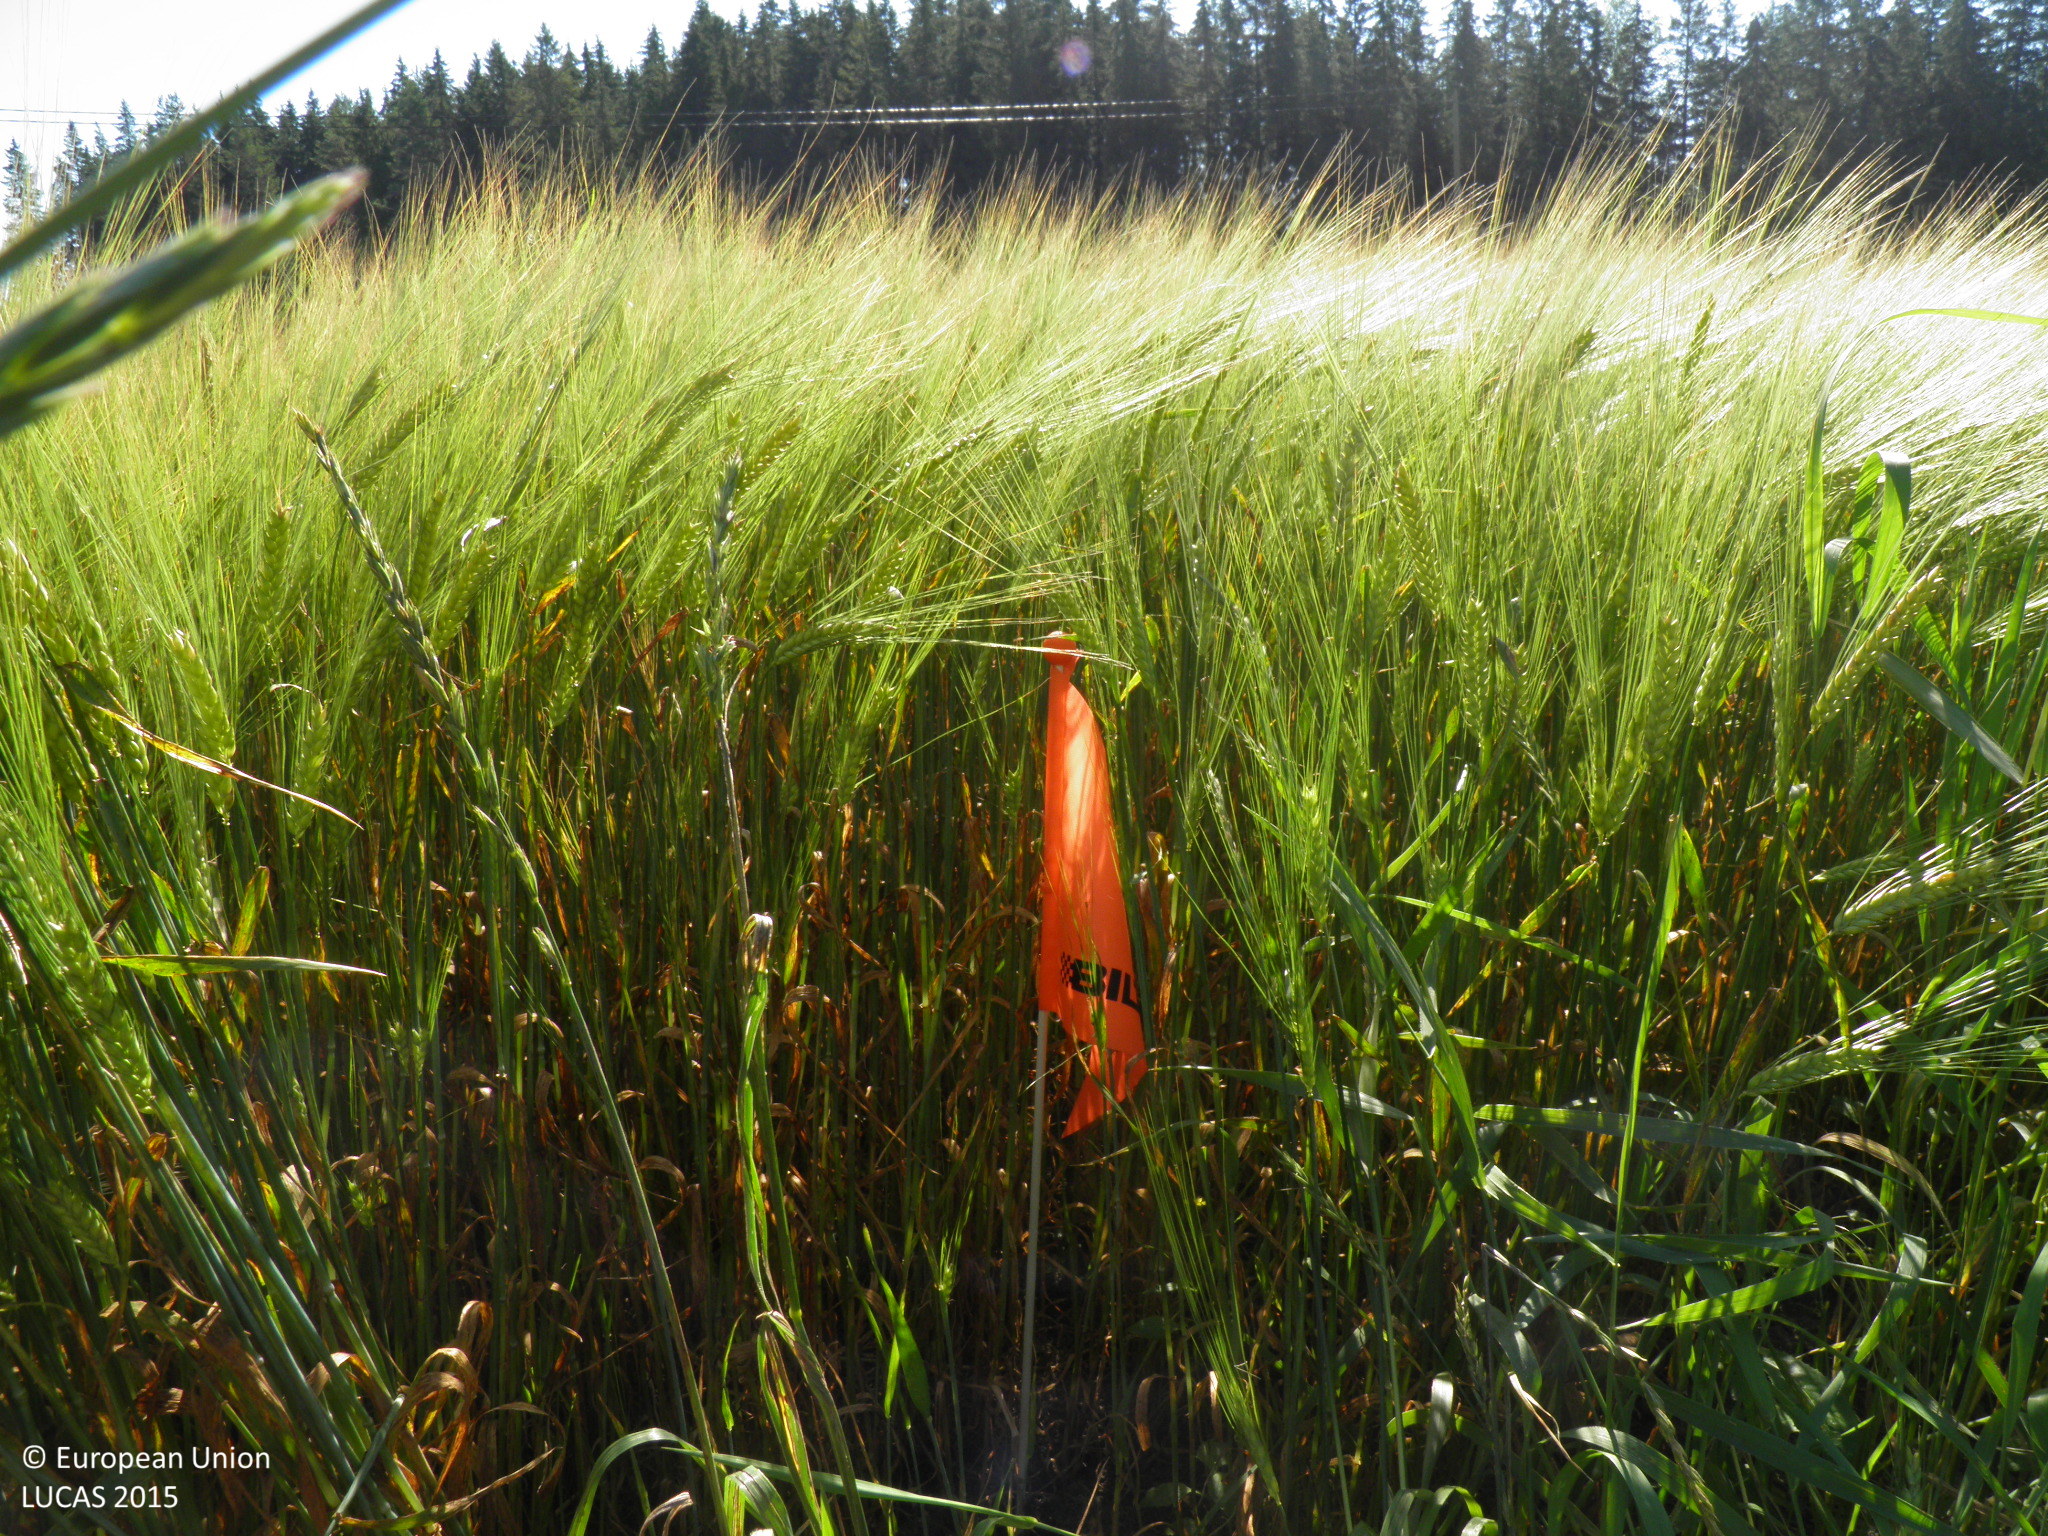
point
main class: Cropland
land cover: Barley
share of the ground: > 75 %
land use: Agriculture (excluding fallow land and kitchen gardens)
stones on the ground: < 10 %
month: August
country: FI
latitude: 60.7631
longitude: 21.9731
